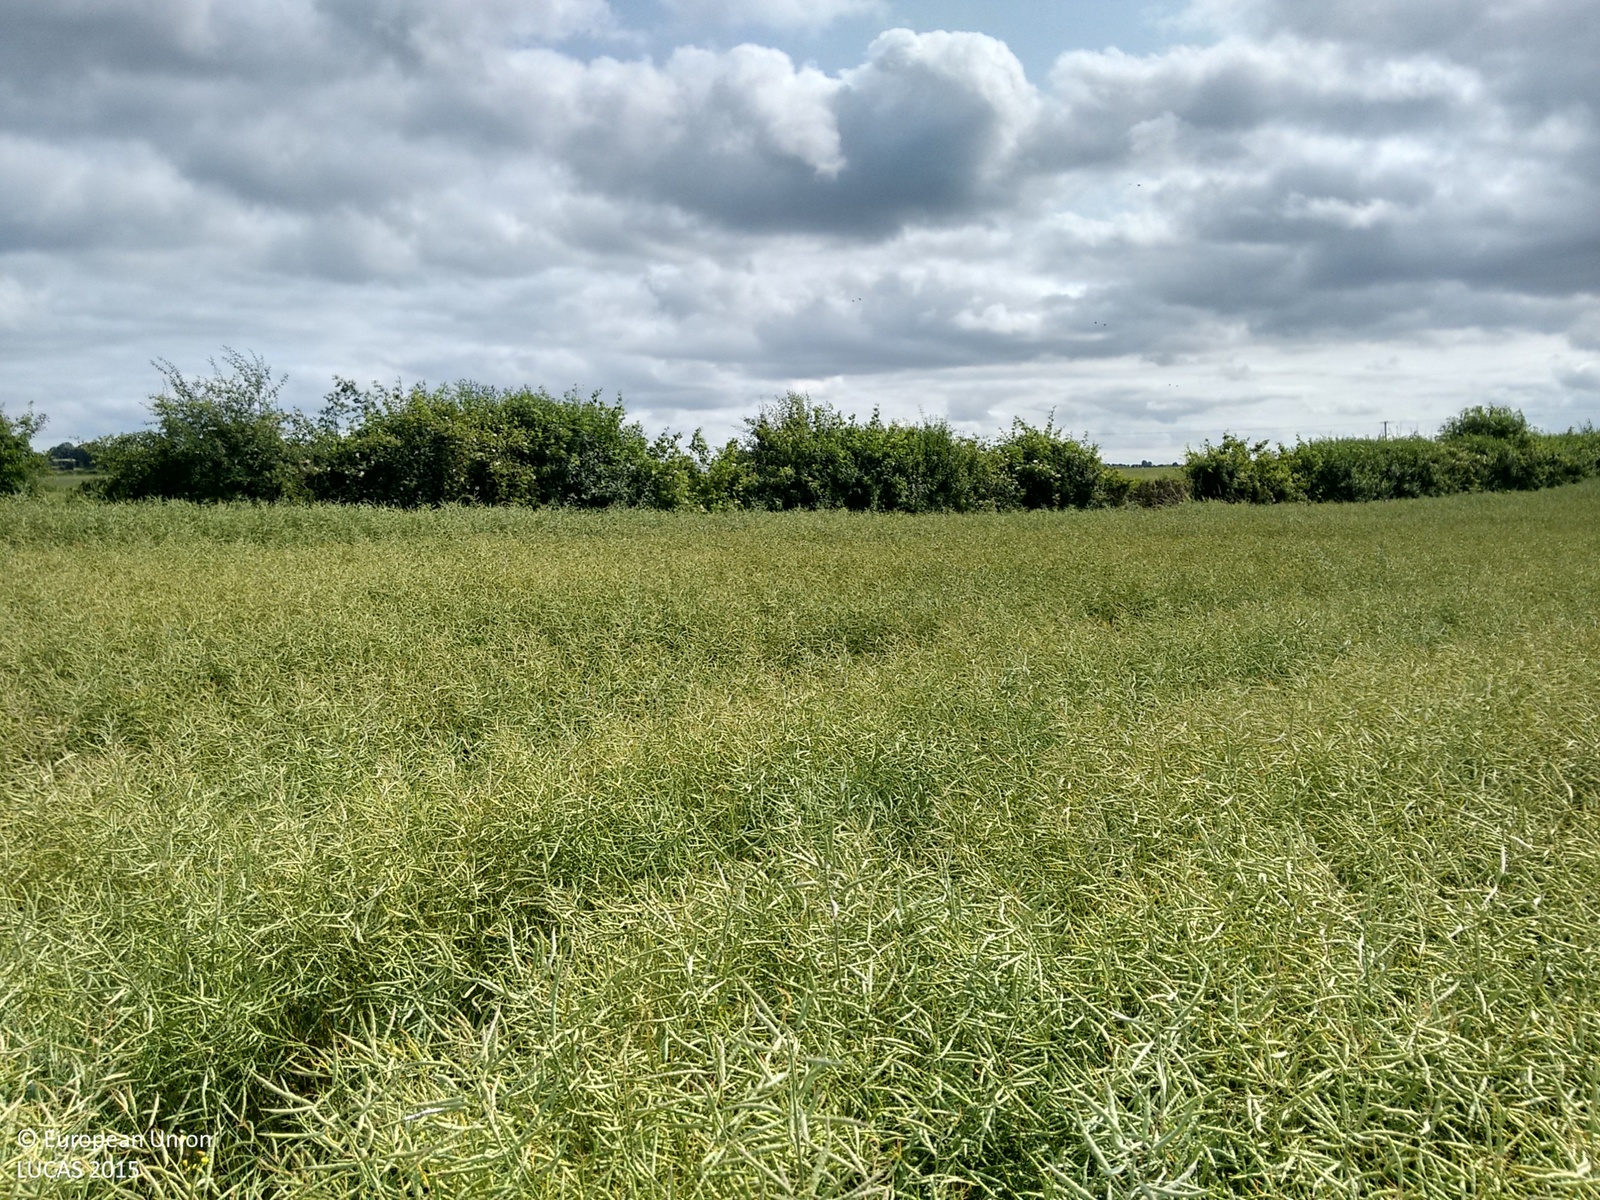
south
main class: Cropland
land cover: Rape and turnip rape
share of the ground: > 75 %
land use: Agriculture (excluding fallow land and kitchen gardens)
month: July
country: IE
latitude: 53.0745
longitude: -6.8400
